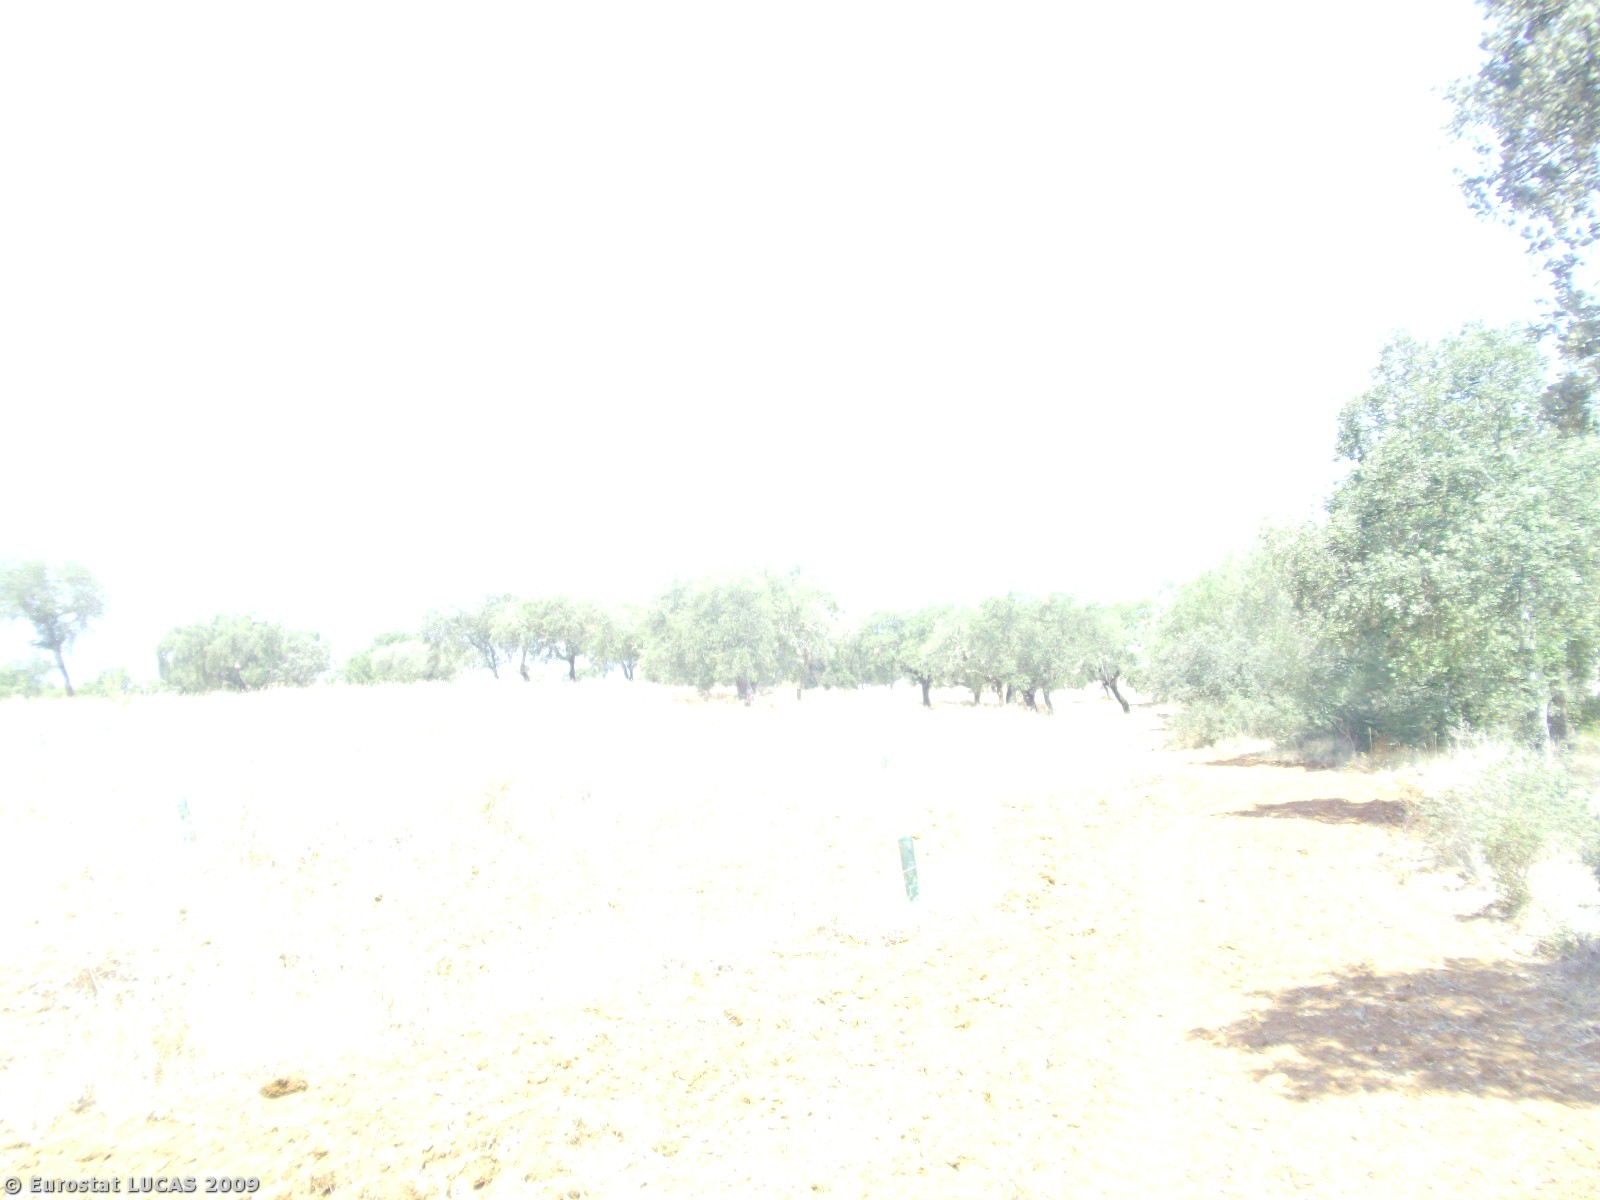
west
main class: Woodland
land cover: Broadleaved woodland
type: broadleaved evergreen forest
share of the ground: 50 - 75 %
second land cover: Bare land
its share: > 75 %
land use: Forestry
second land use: Fallow land
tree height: > 5 m
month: August
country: PT
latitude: 38.4047
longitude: -7.8884
